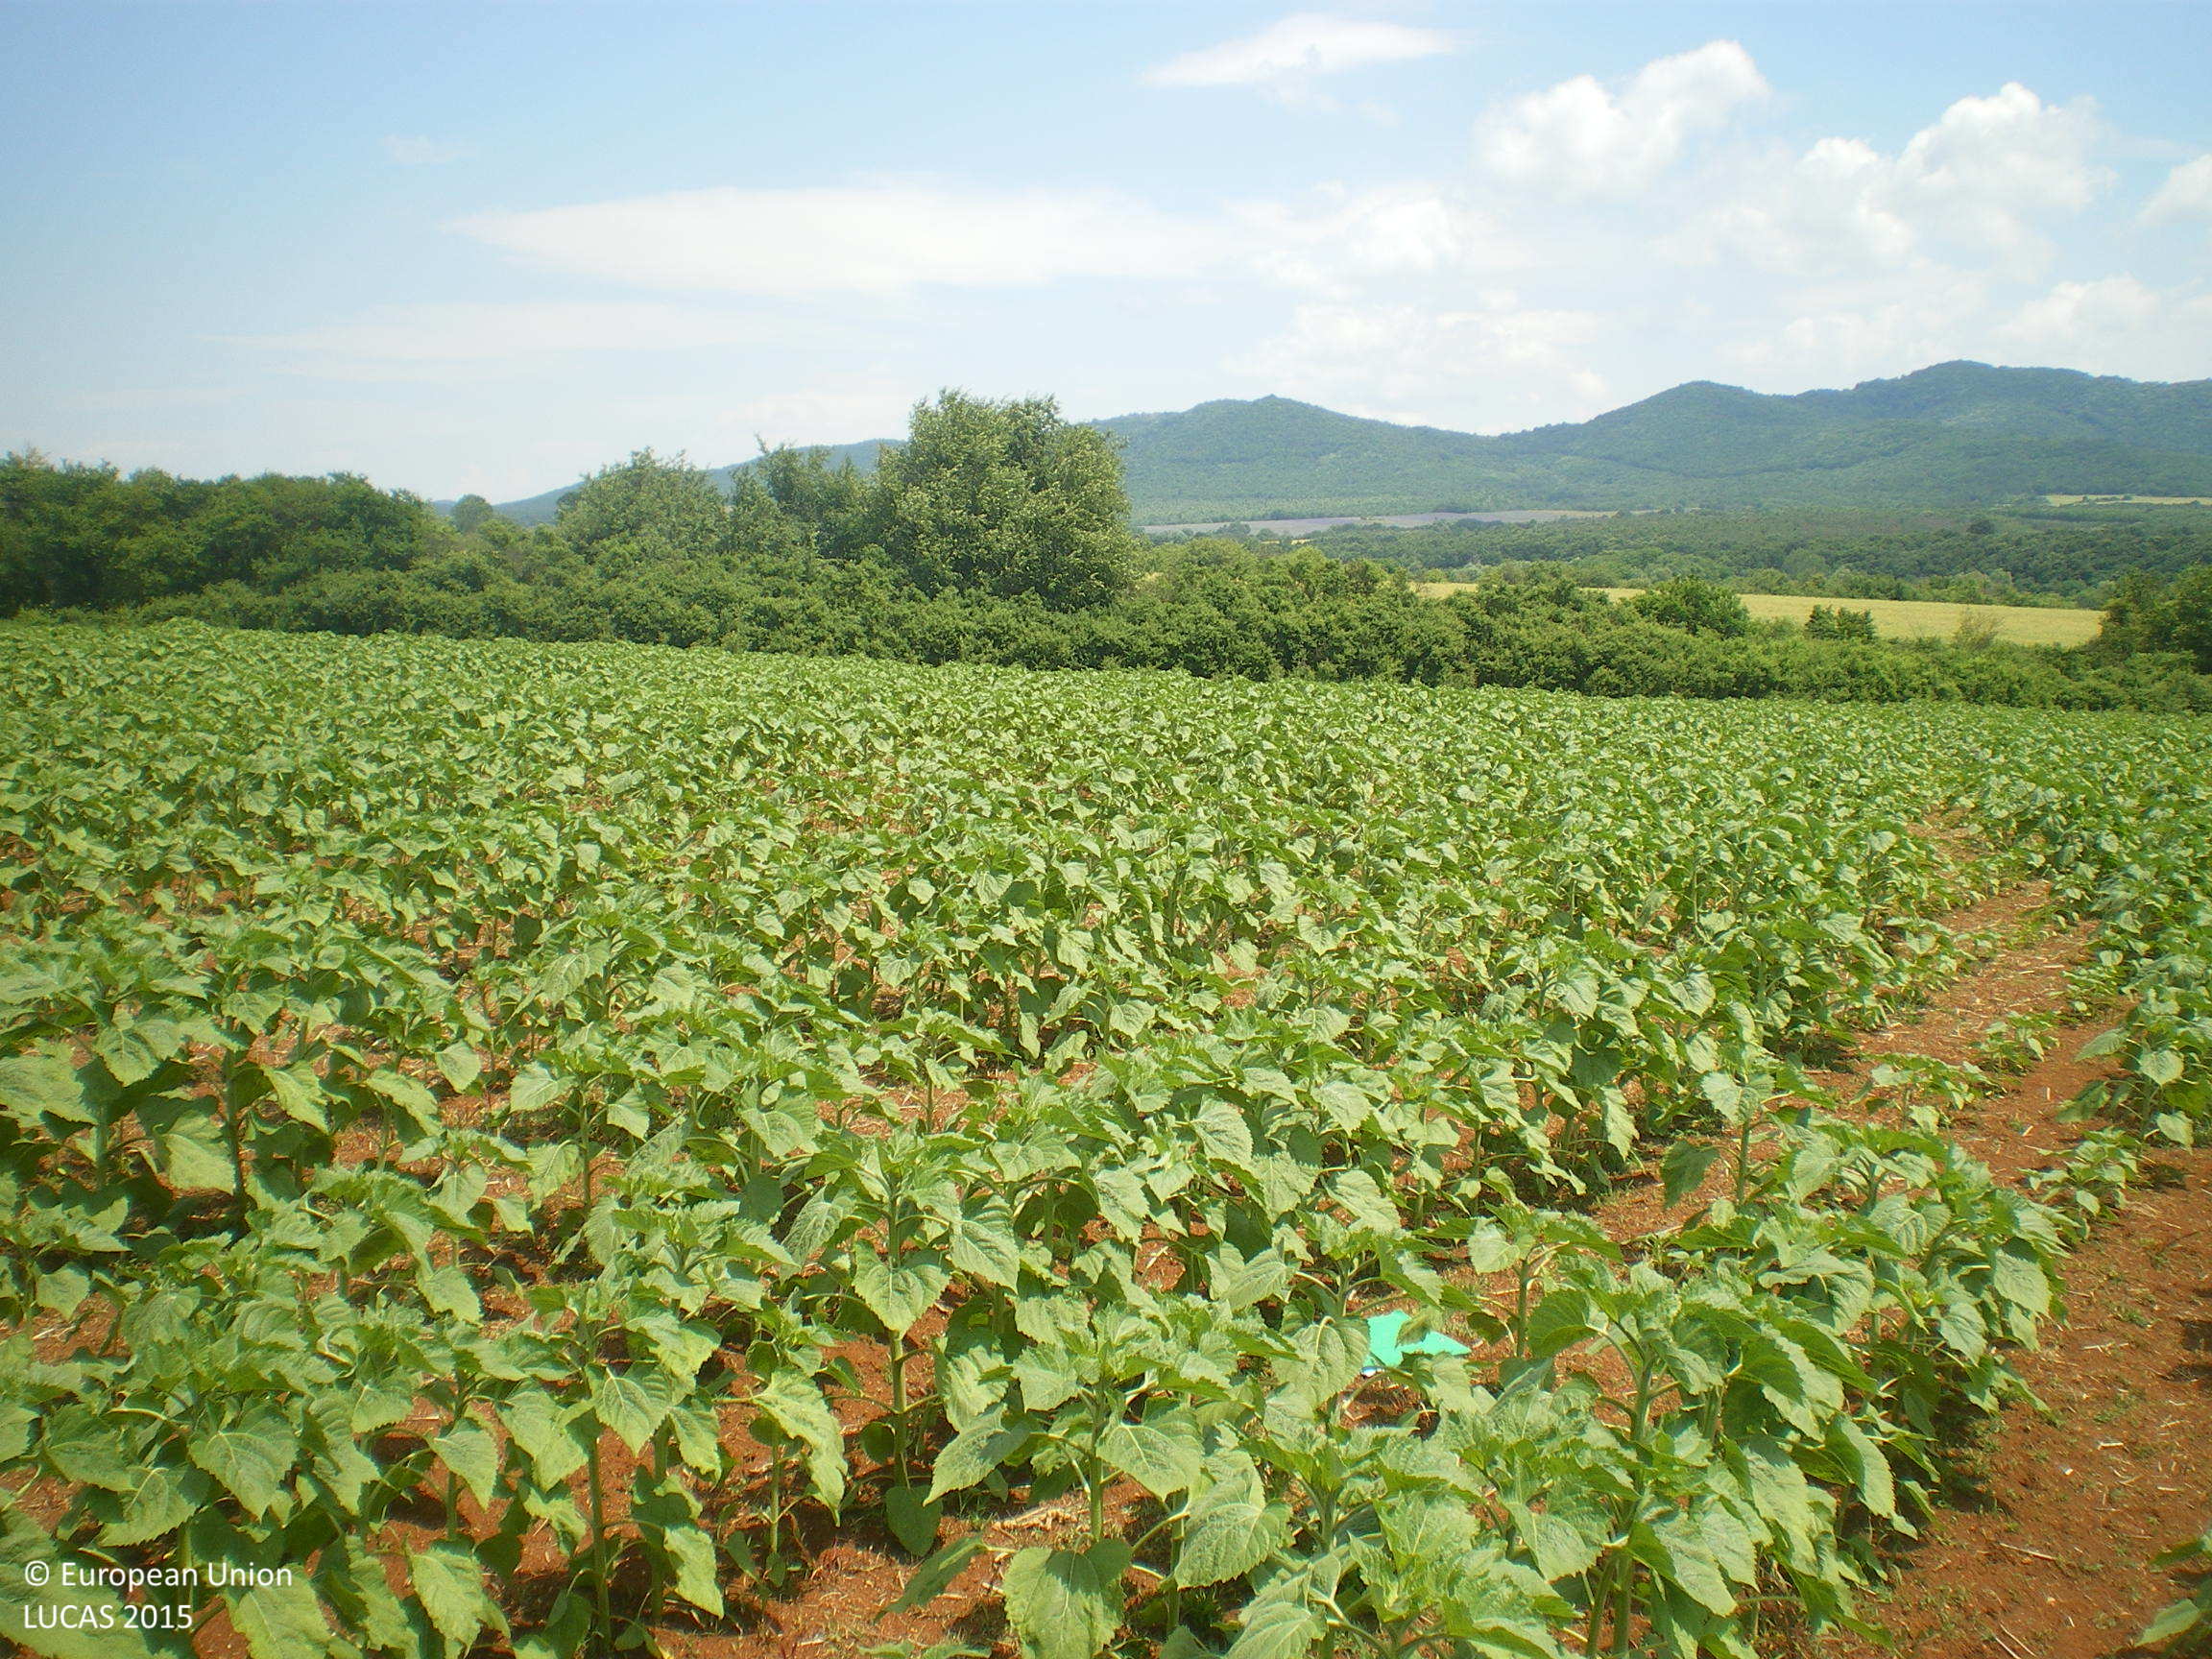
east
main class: Cropland
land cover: Sunflower
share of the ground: 50 - 75 %
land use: Agriculture (excluding fallow land and kitchen gardens)
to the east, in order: Sunflower; Grass margins; Broadleaved woodland; Rape and turnip rape
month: June
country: BG
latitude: 42.3675
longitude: 25.2792
